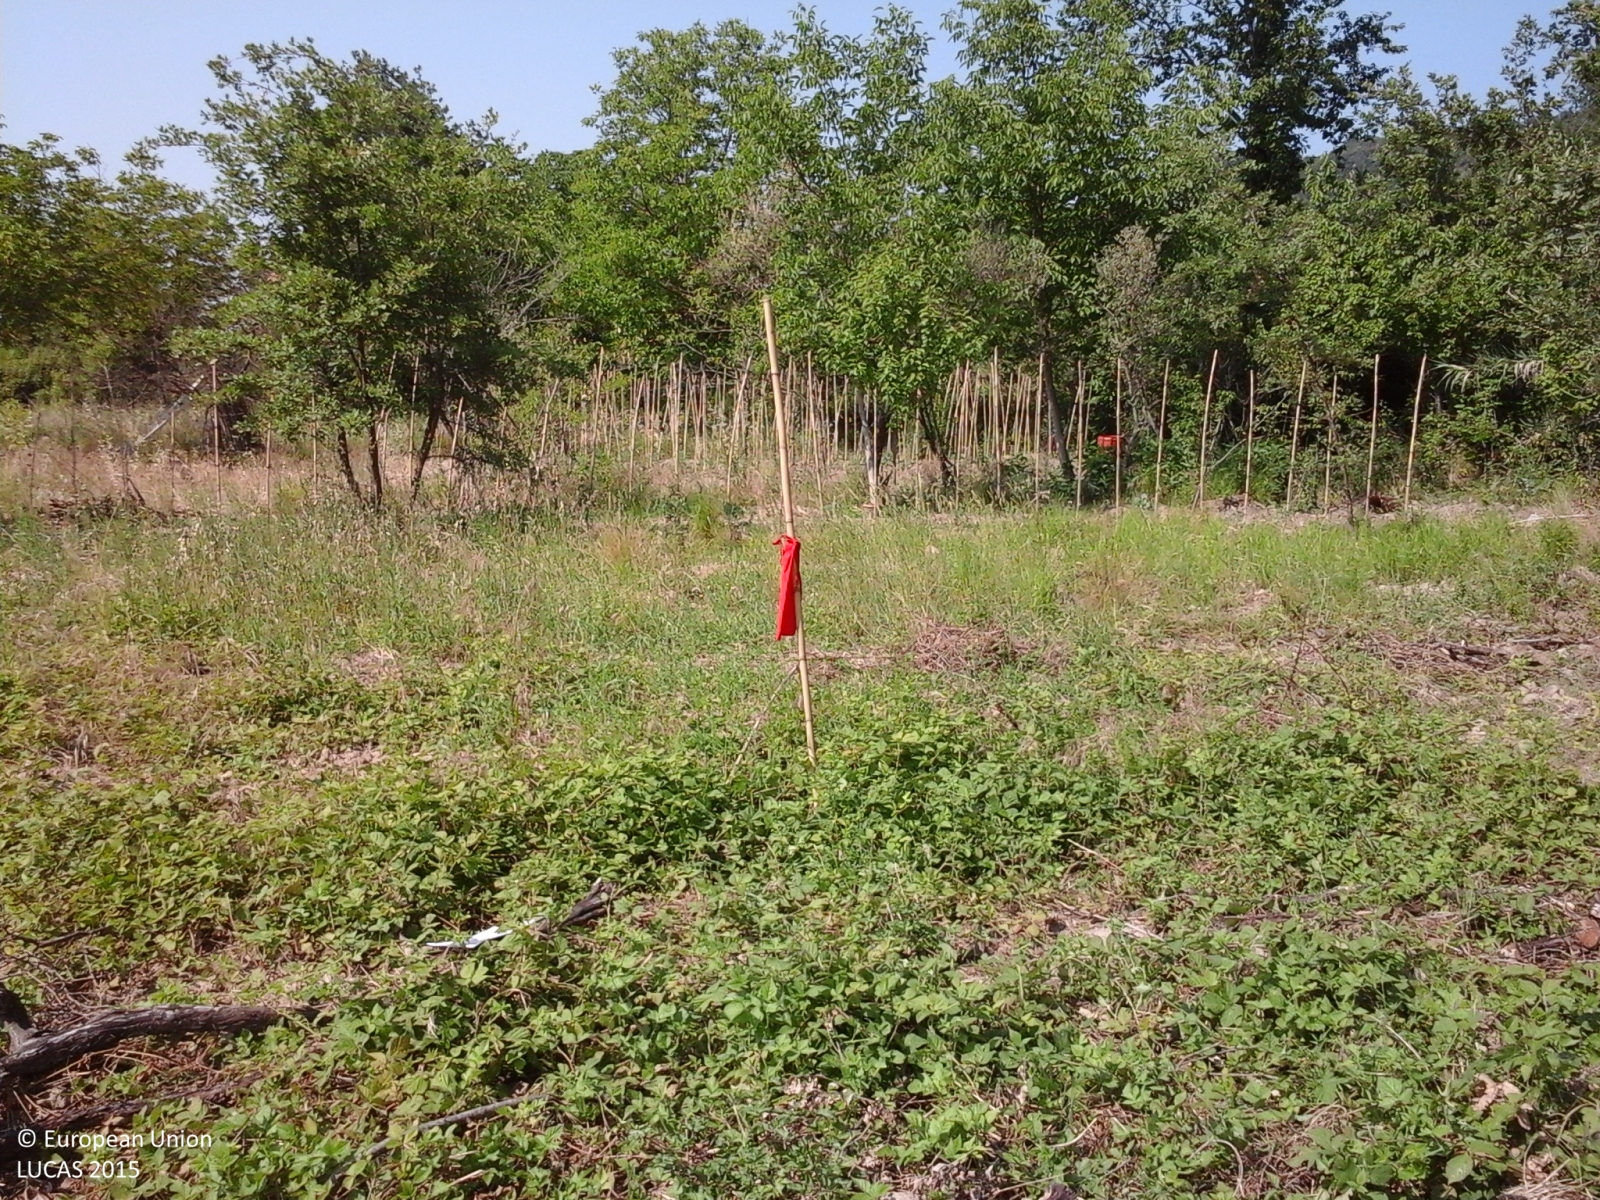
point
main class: Grassland
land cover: Spontaneously vegetated surfaces
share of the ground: > 75 %
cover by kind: herbaceous plants 50 %, consolidated bare surface 50 %
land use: Fallow land
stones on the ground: < 10 %
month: June
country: IT
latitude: 42.0722
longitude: 14.3494
